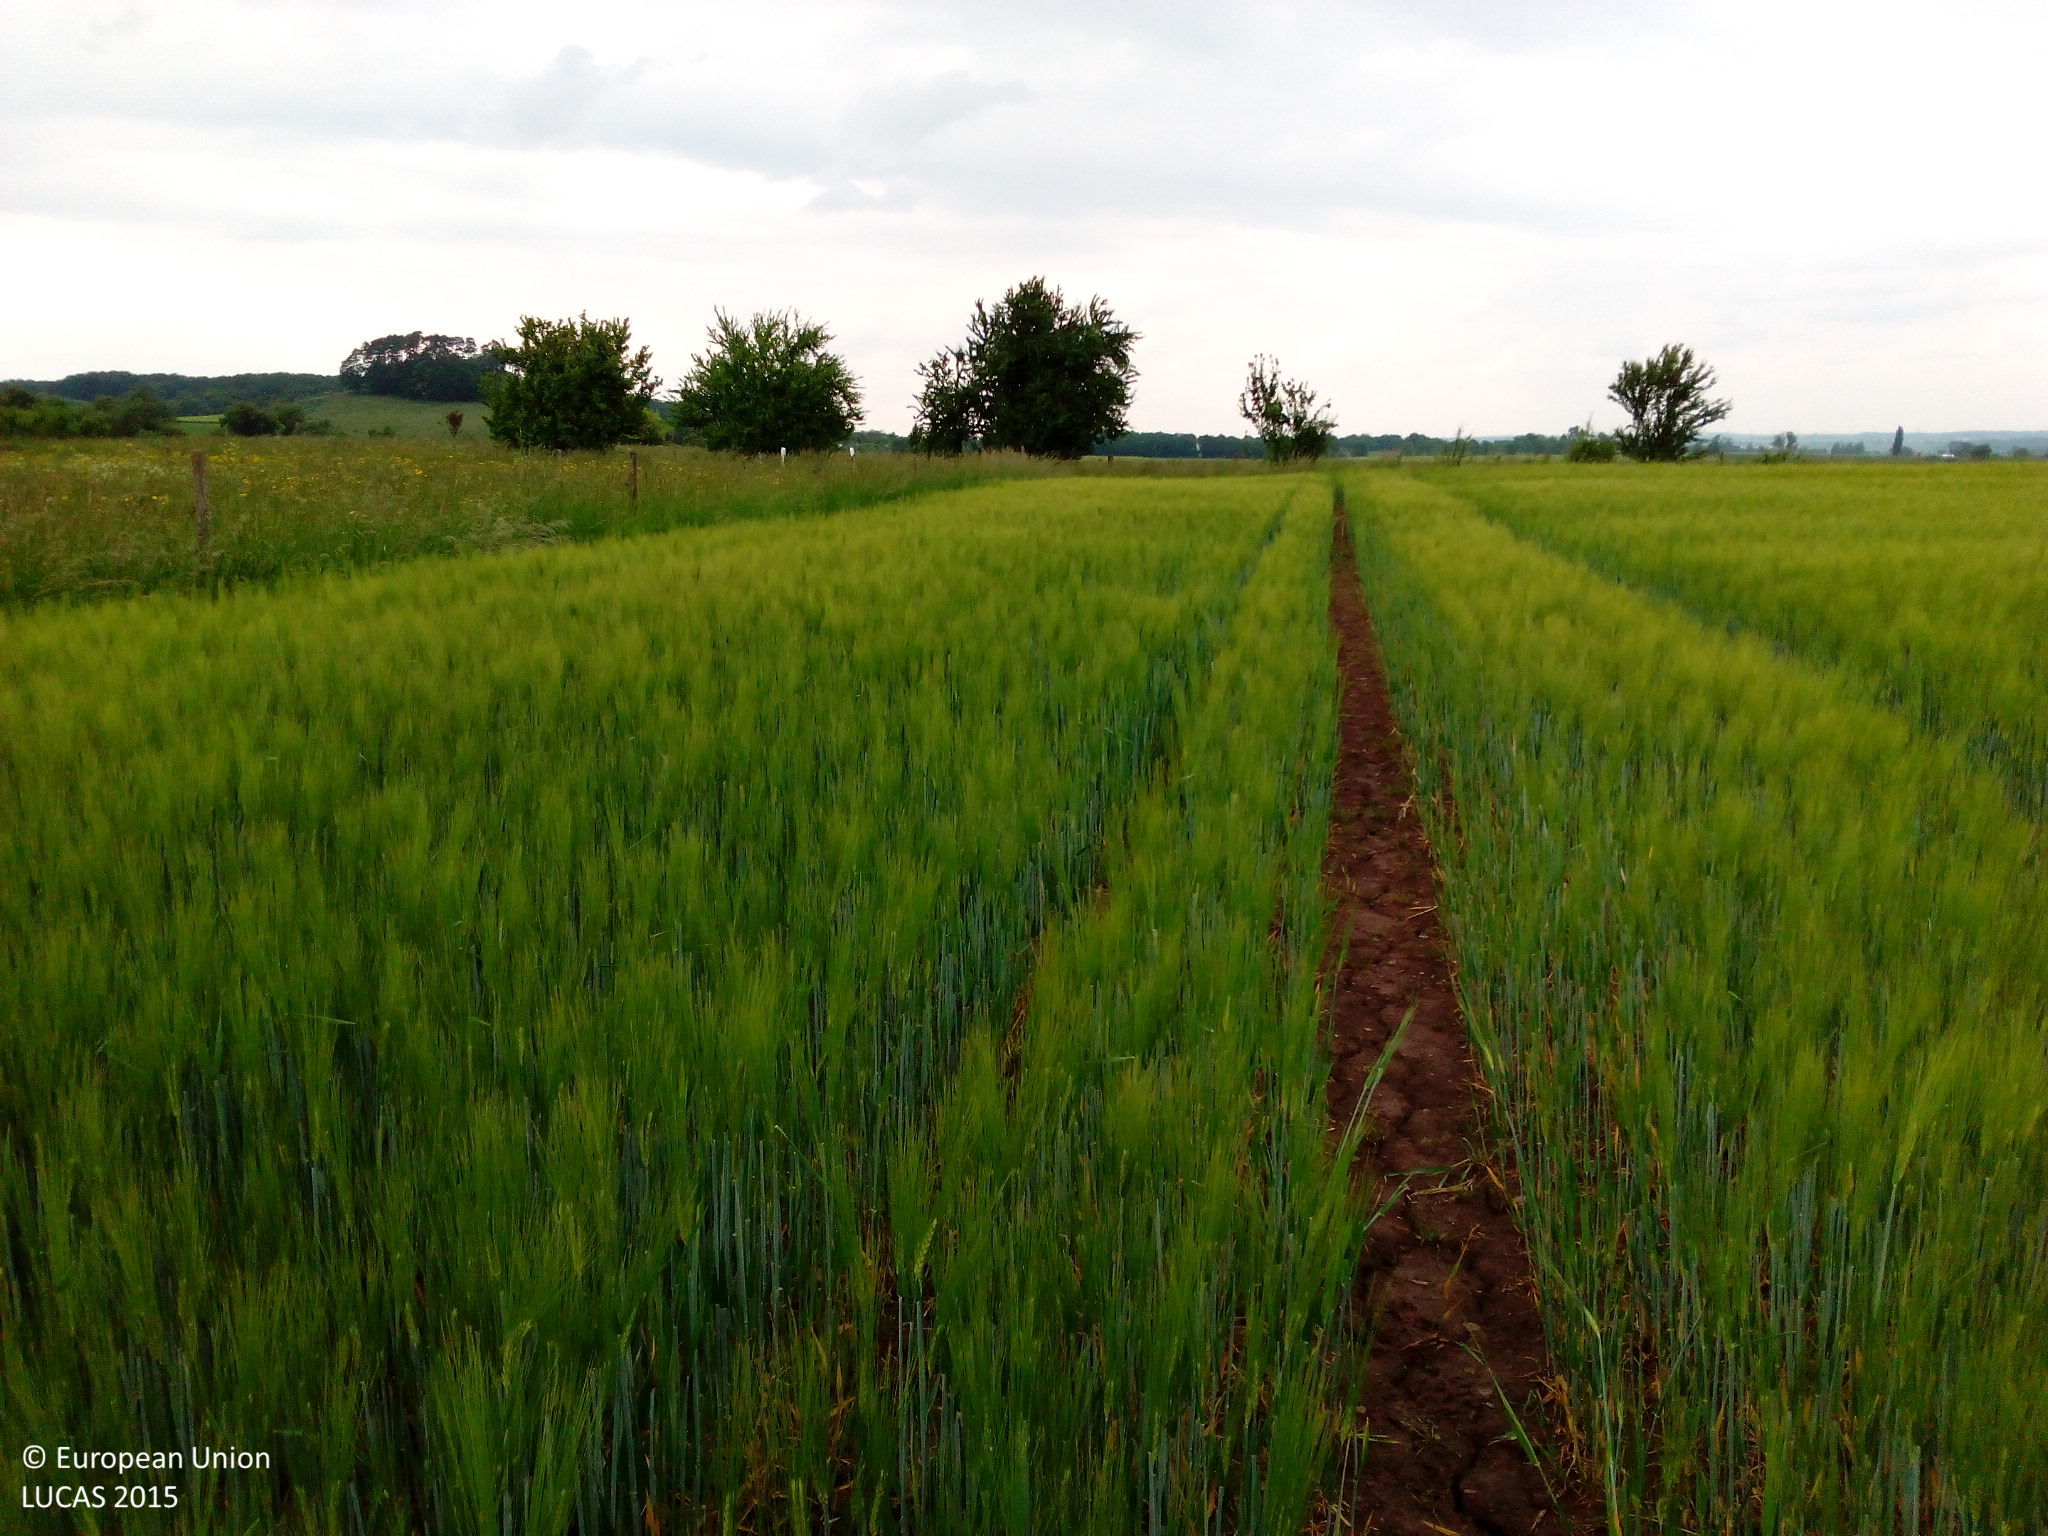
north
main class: Cropland
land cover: Barley
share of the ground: > 75 %
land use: Agriculture (excluding fallow land and kitchen gardens)
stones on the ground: < 10 %
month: May
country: DE
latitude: 49.1766
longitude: 9.6846
